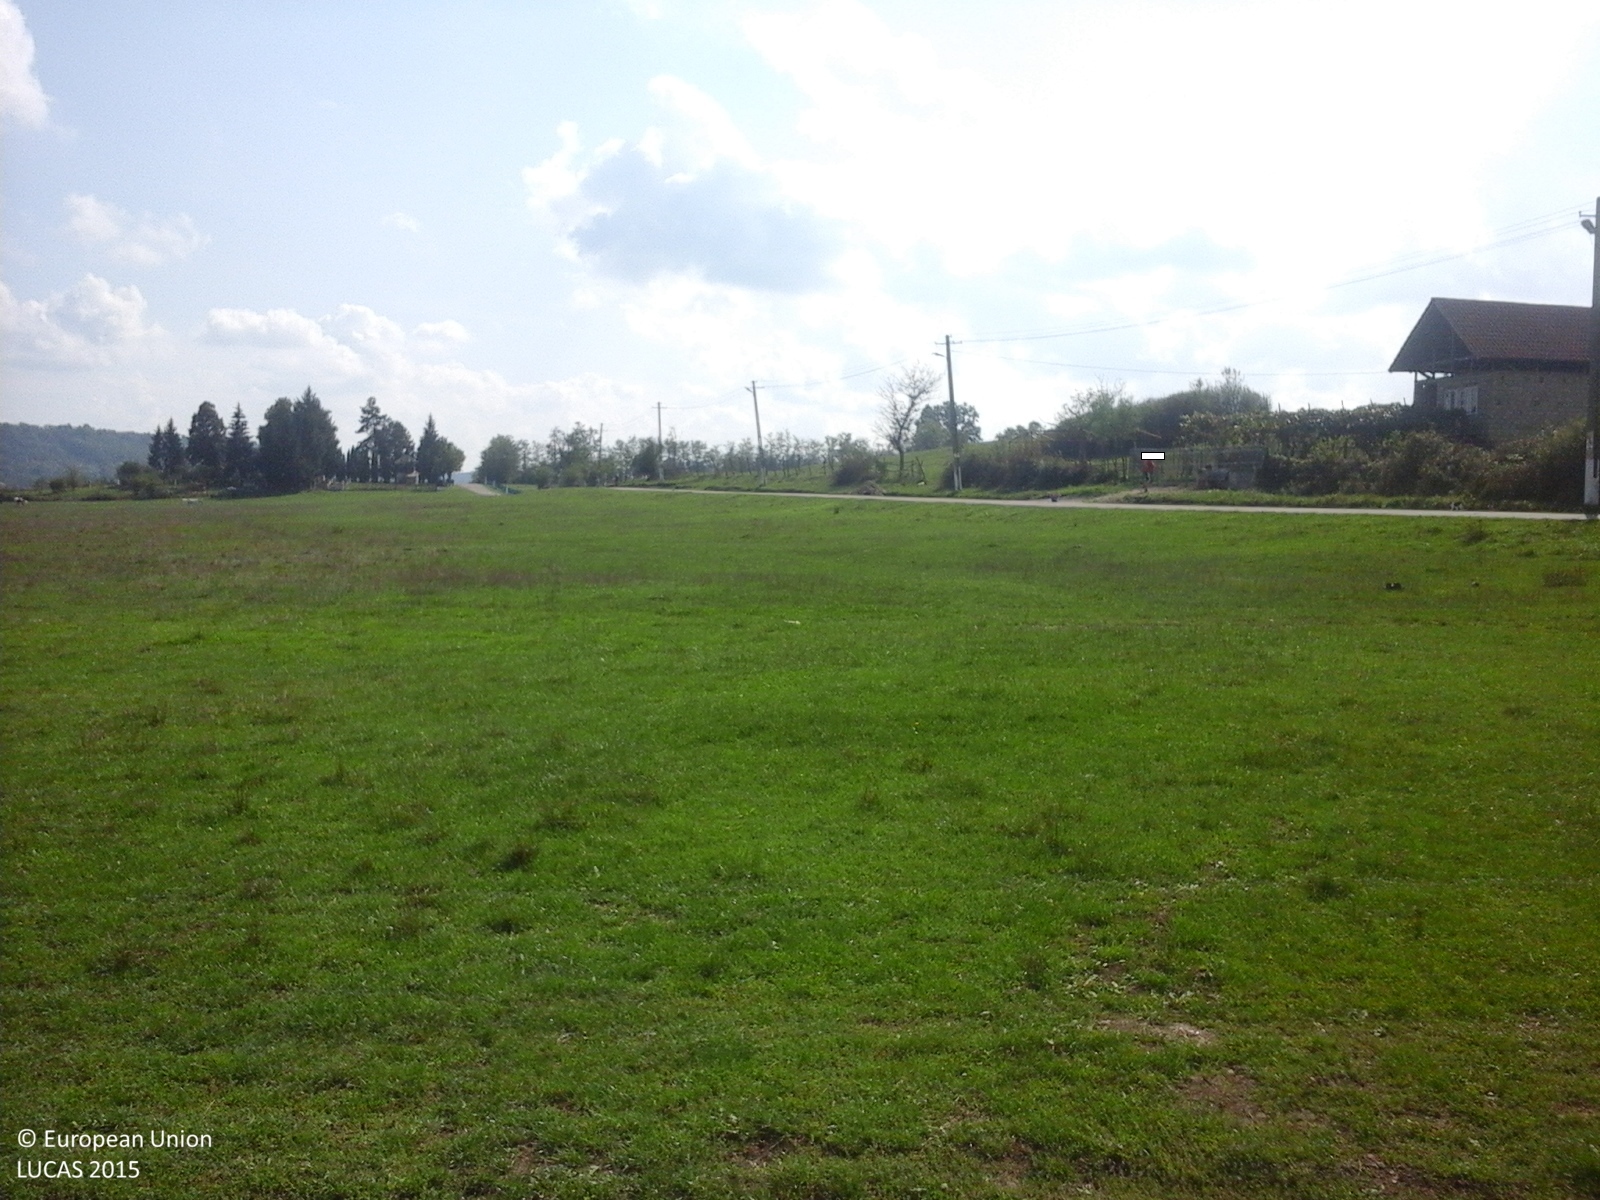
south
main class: Grassland
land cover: Grassland without tree/shrub cover
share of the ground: > 75 %
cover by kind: herbaceous plants 100 %
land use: Agriculture (excluding fallow land and kitchen gardens)
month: September
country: RO
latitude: 45.0126
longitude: 22.9530
